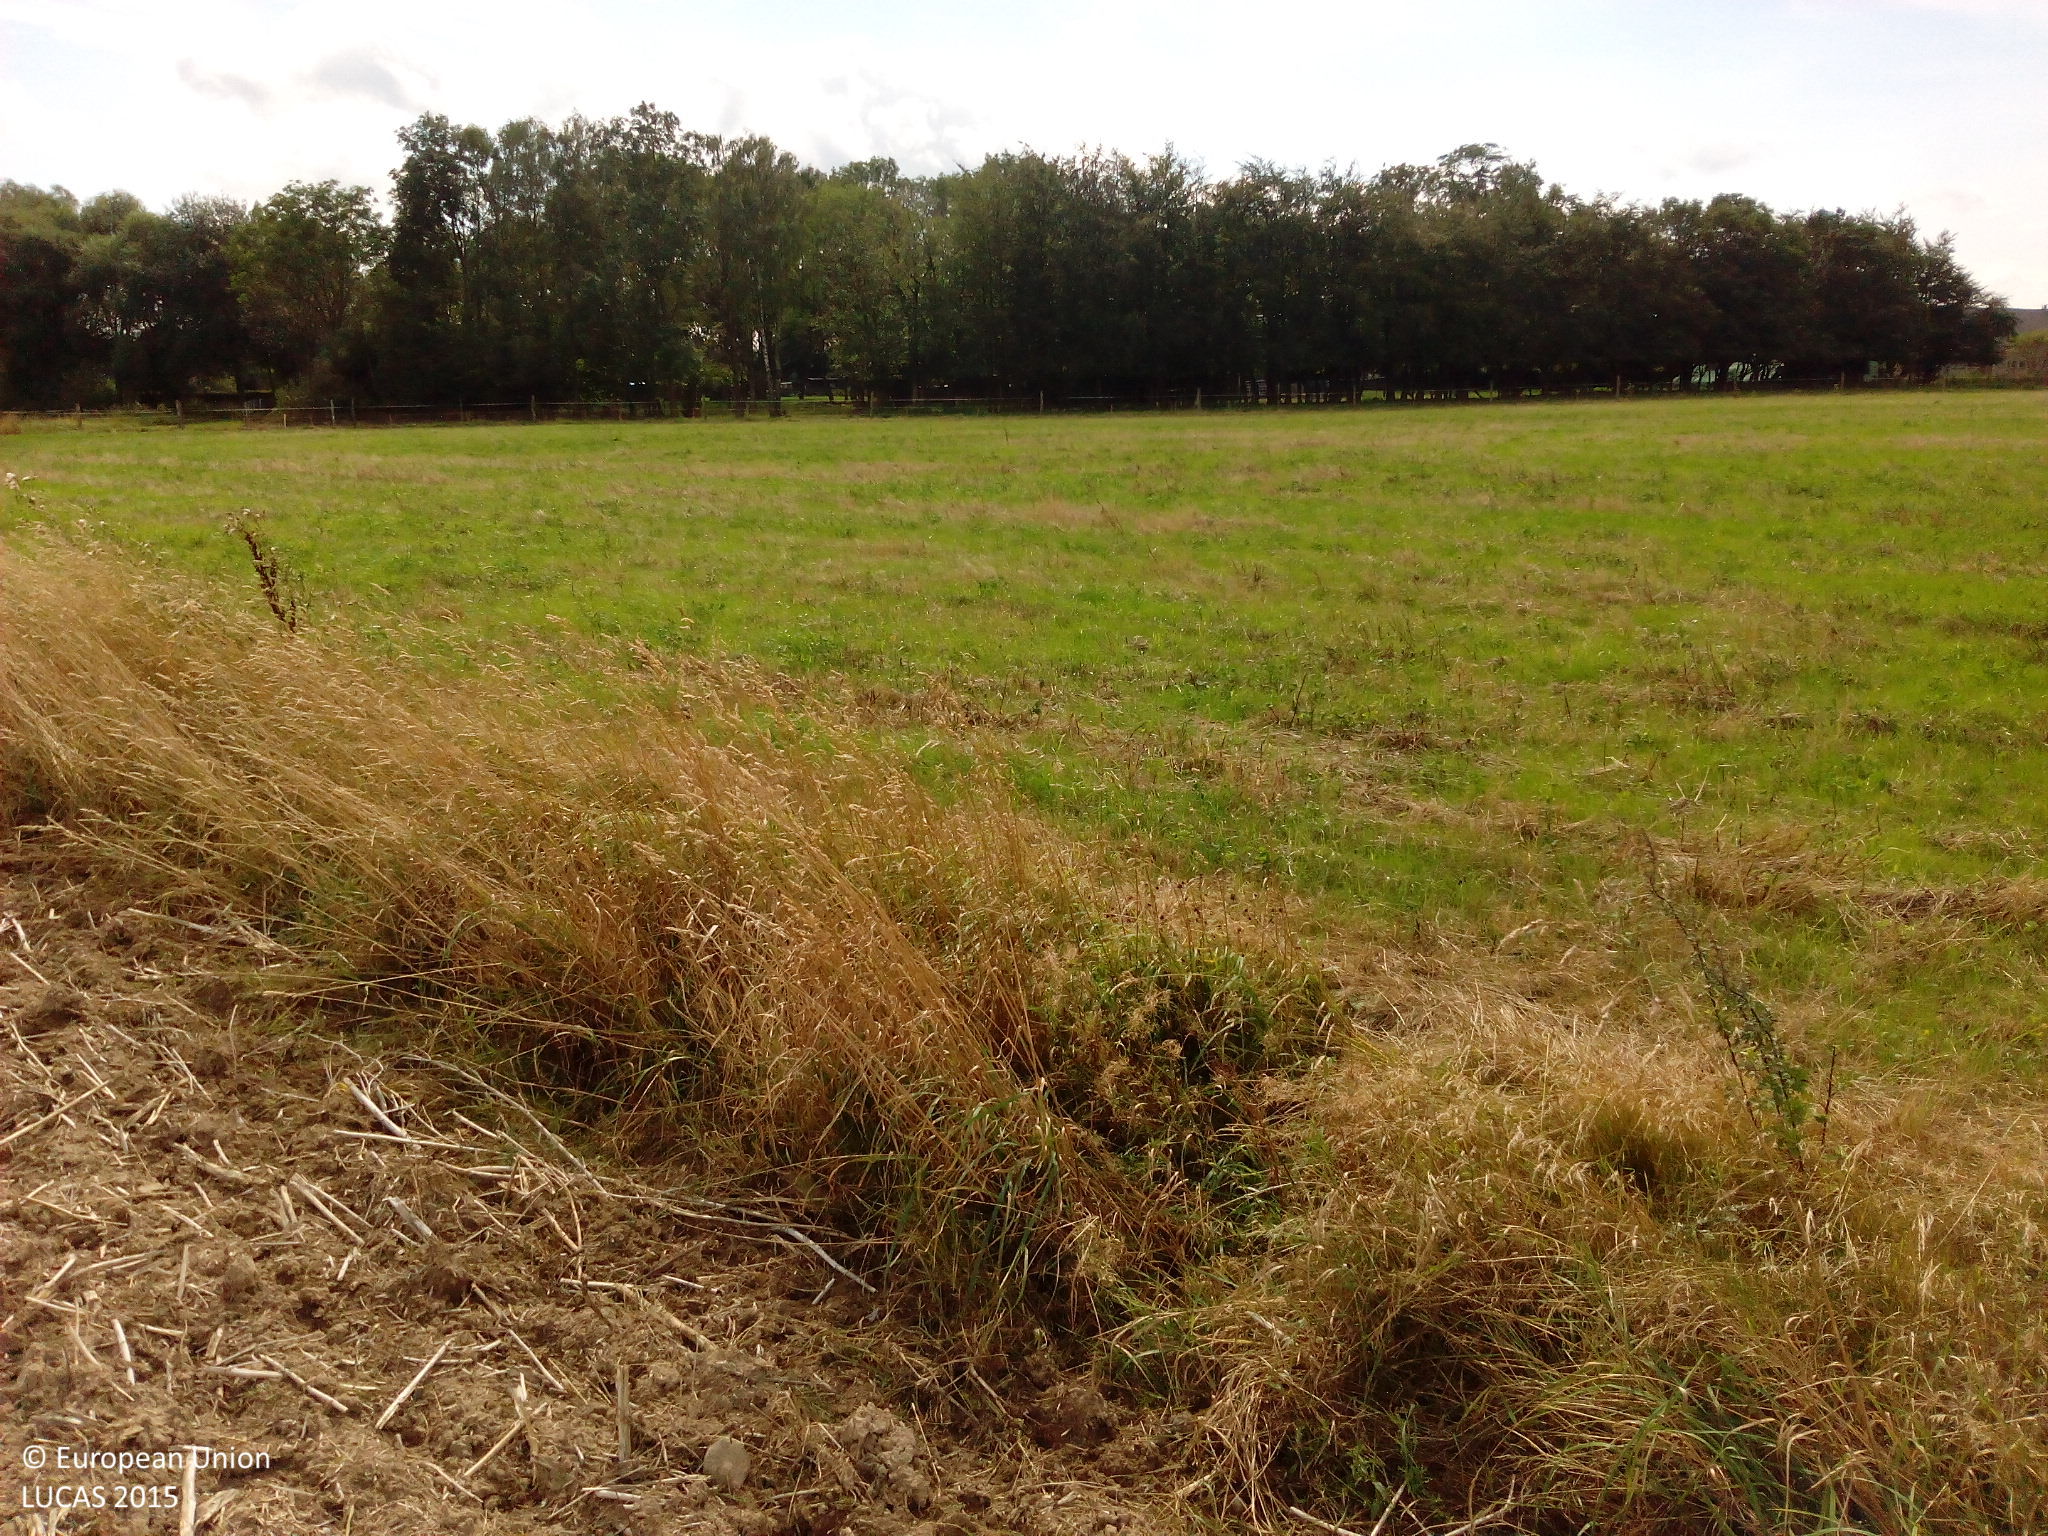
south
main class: Cropland
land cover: Rape and turnip rape
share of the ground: < 10 %
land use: Agriculture (excluding fallow land and kitchen gardens)
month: September
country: DE
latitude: 54.1501
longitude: 12.4641
